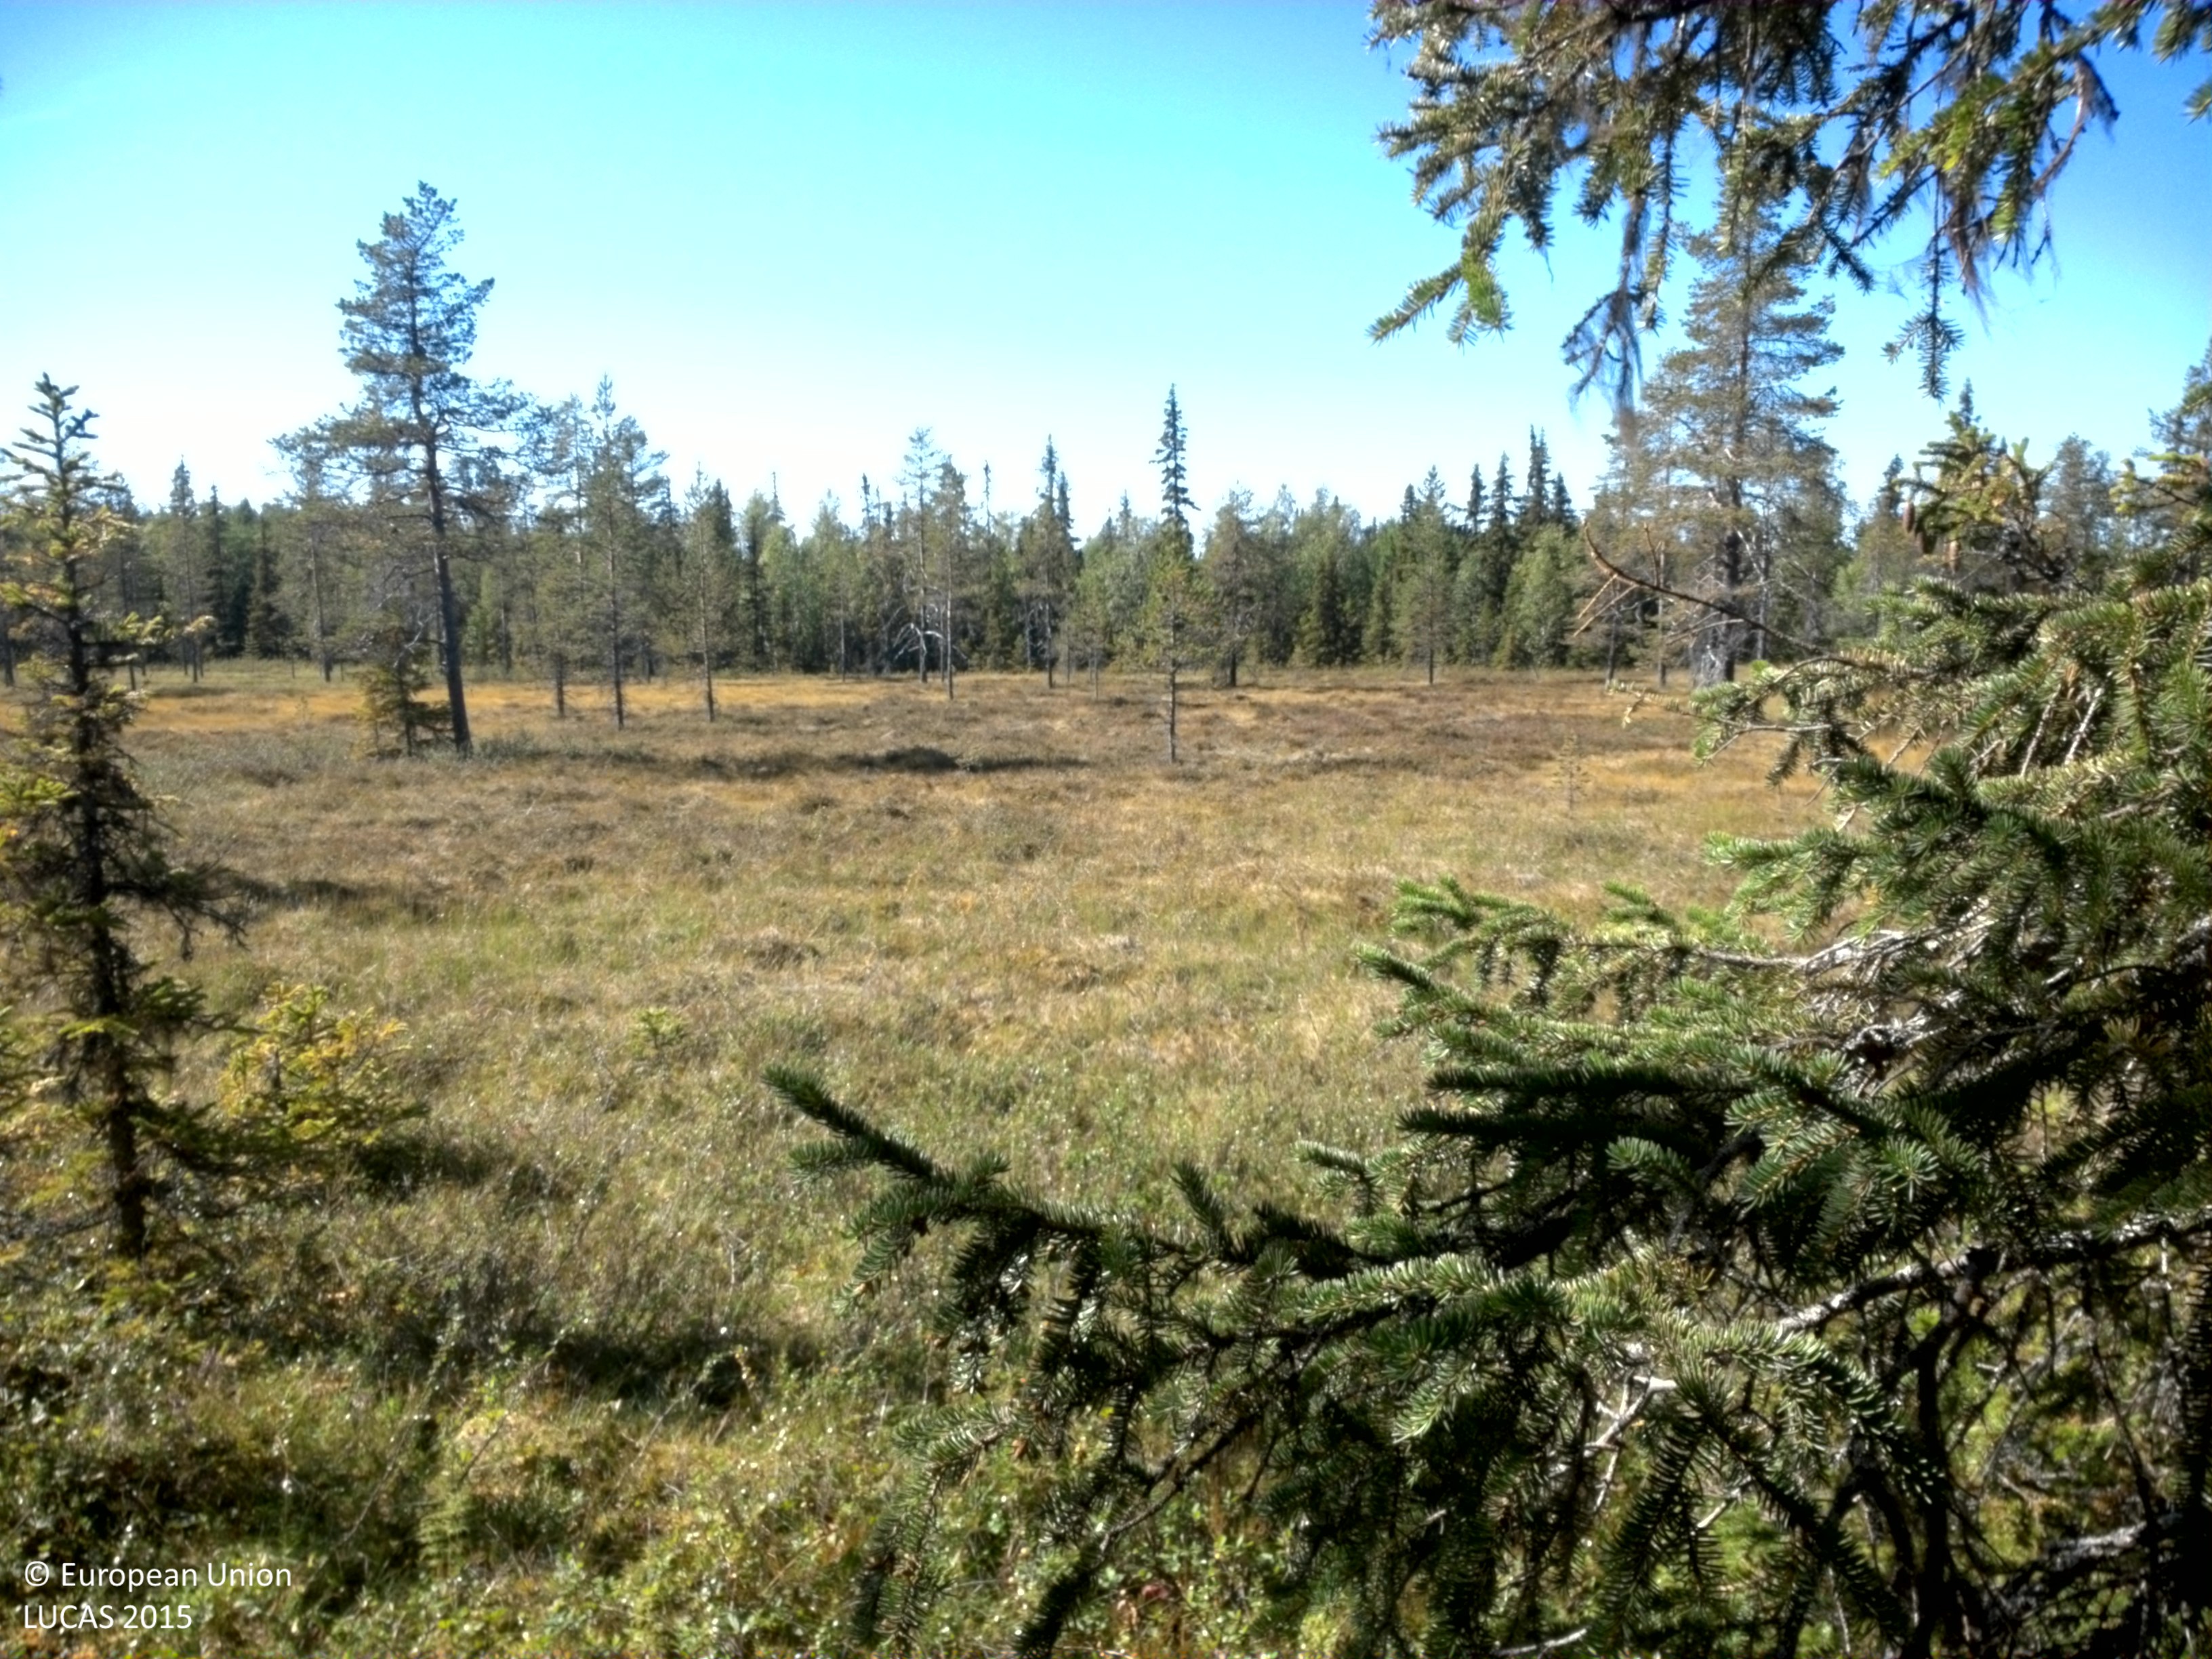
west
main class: Woodland
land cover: Other mixed woodland
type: boreal forest
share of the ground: 25 - 50 %
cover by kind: shrubs 55 %, coniferous forest trees 25 %, broadleaved forest trees 10 %, herbaceous plants 5 %, lichens and mosses 5 %
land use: Forestry
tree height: > 5 m
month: August
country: SE
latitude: 64.7691
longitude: 16.1274
